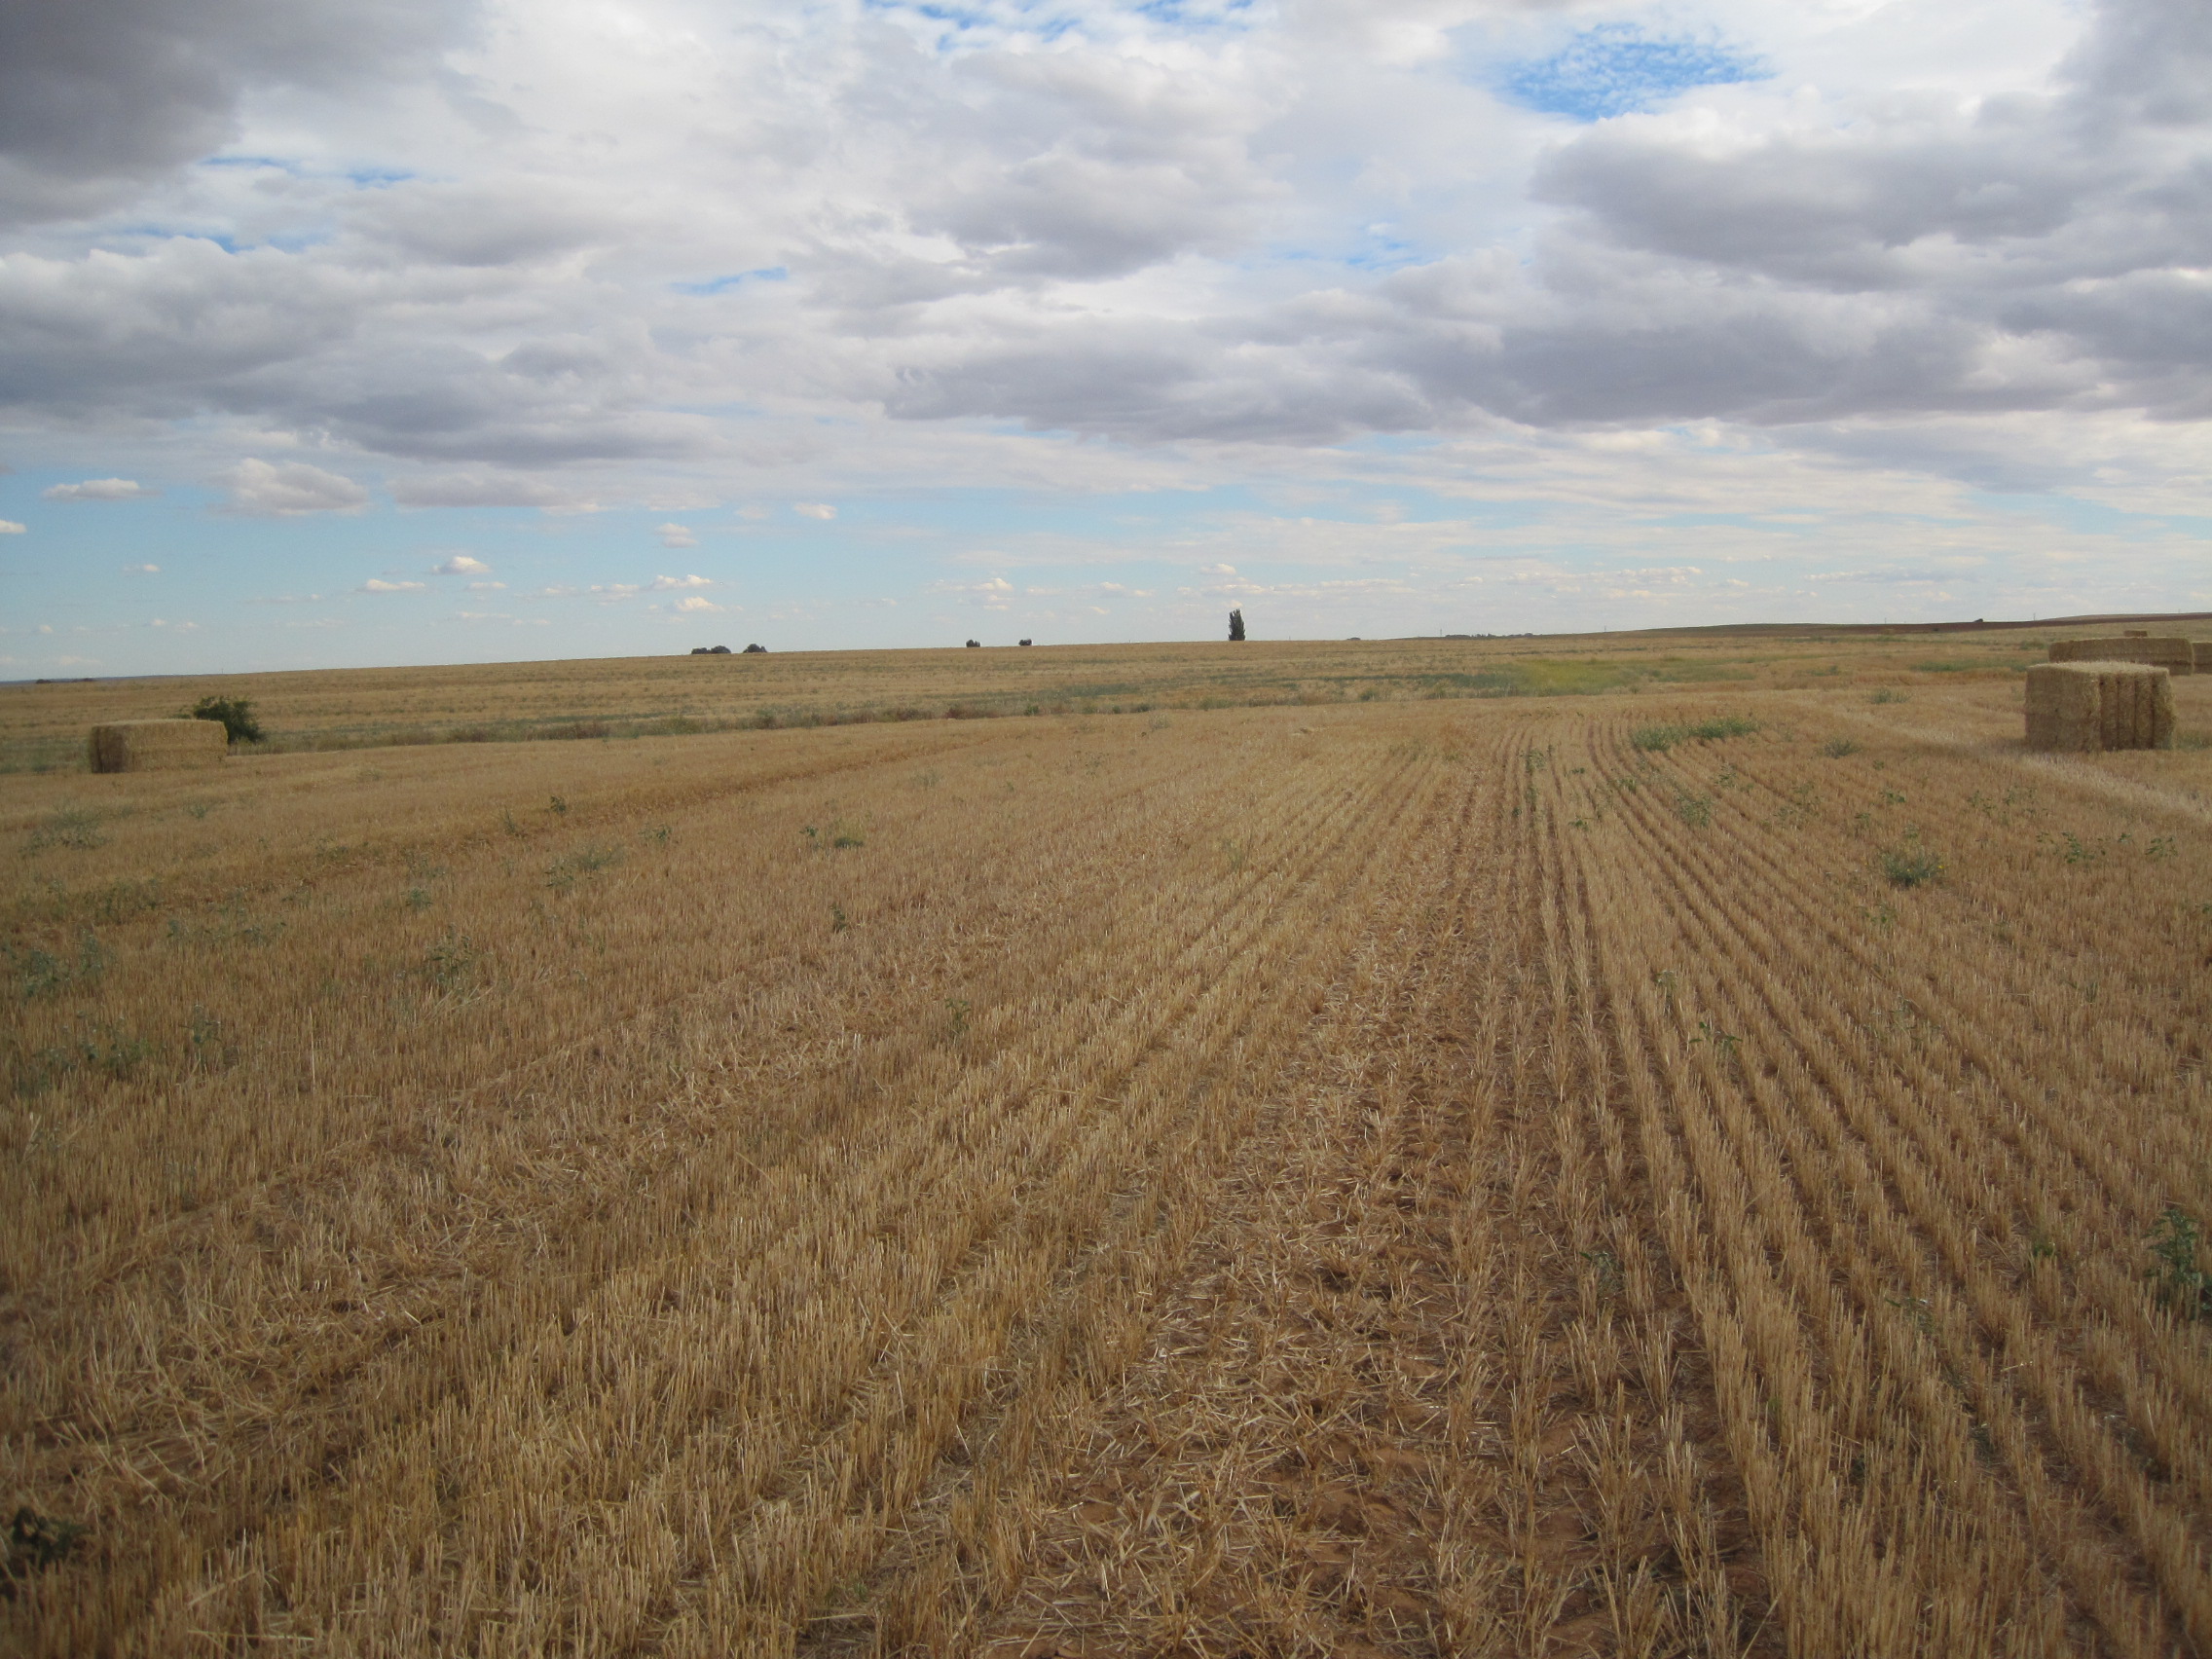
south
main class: Cropland
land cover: Barley
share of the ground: < 10 %
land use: Agriculture (excluding fallow land and kitchen gardens)
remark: Harvested field
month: July
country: ES
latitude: 41.9669
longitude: -5.4966
